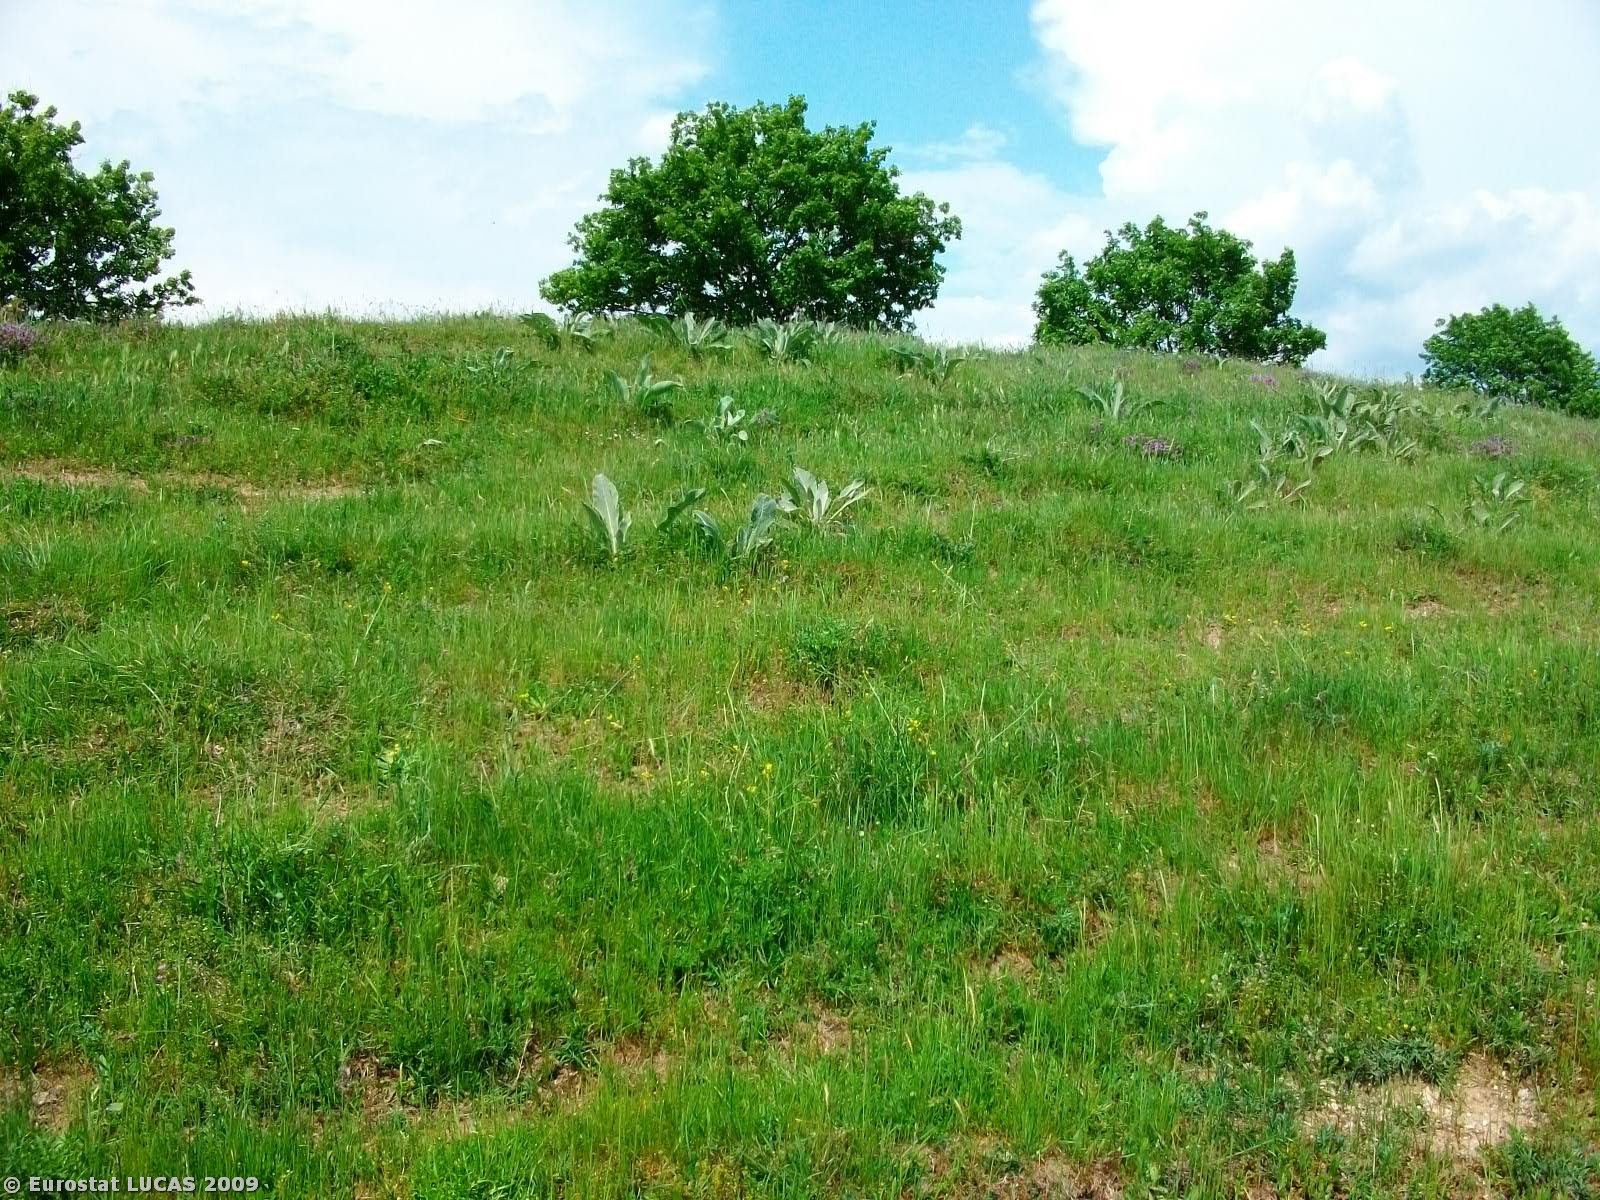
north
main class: Grassland
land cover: Grassland without tree/shrub cover
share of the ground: 50 - 75 %
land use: Agriculture (excluding fallow land and kitchen gardens)
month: May
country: GR
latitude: 41.2369
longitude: 24.6303
